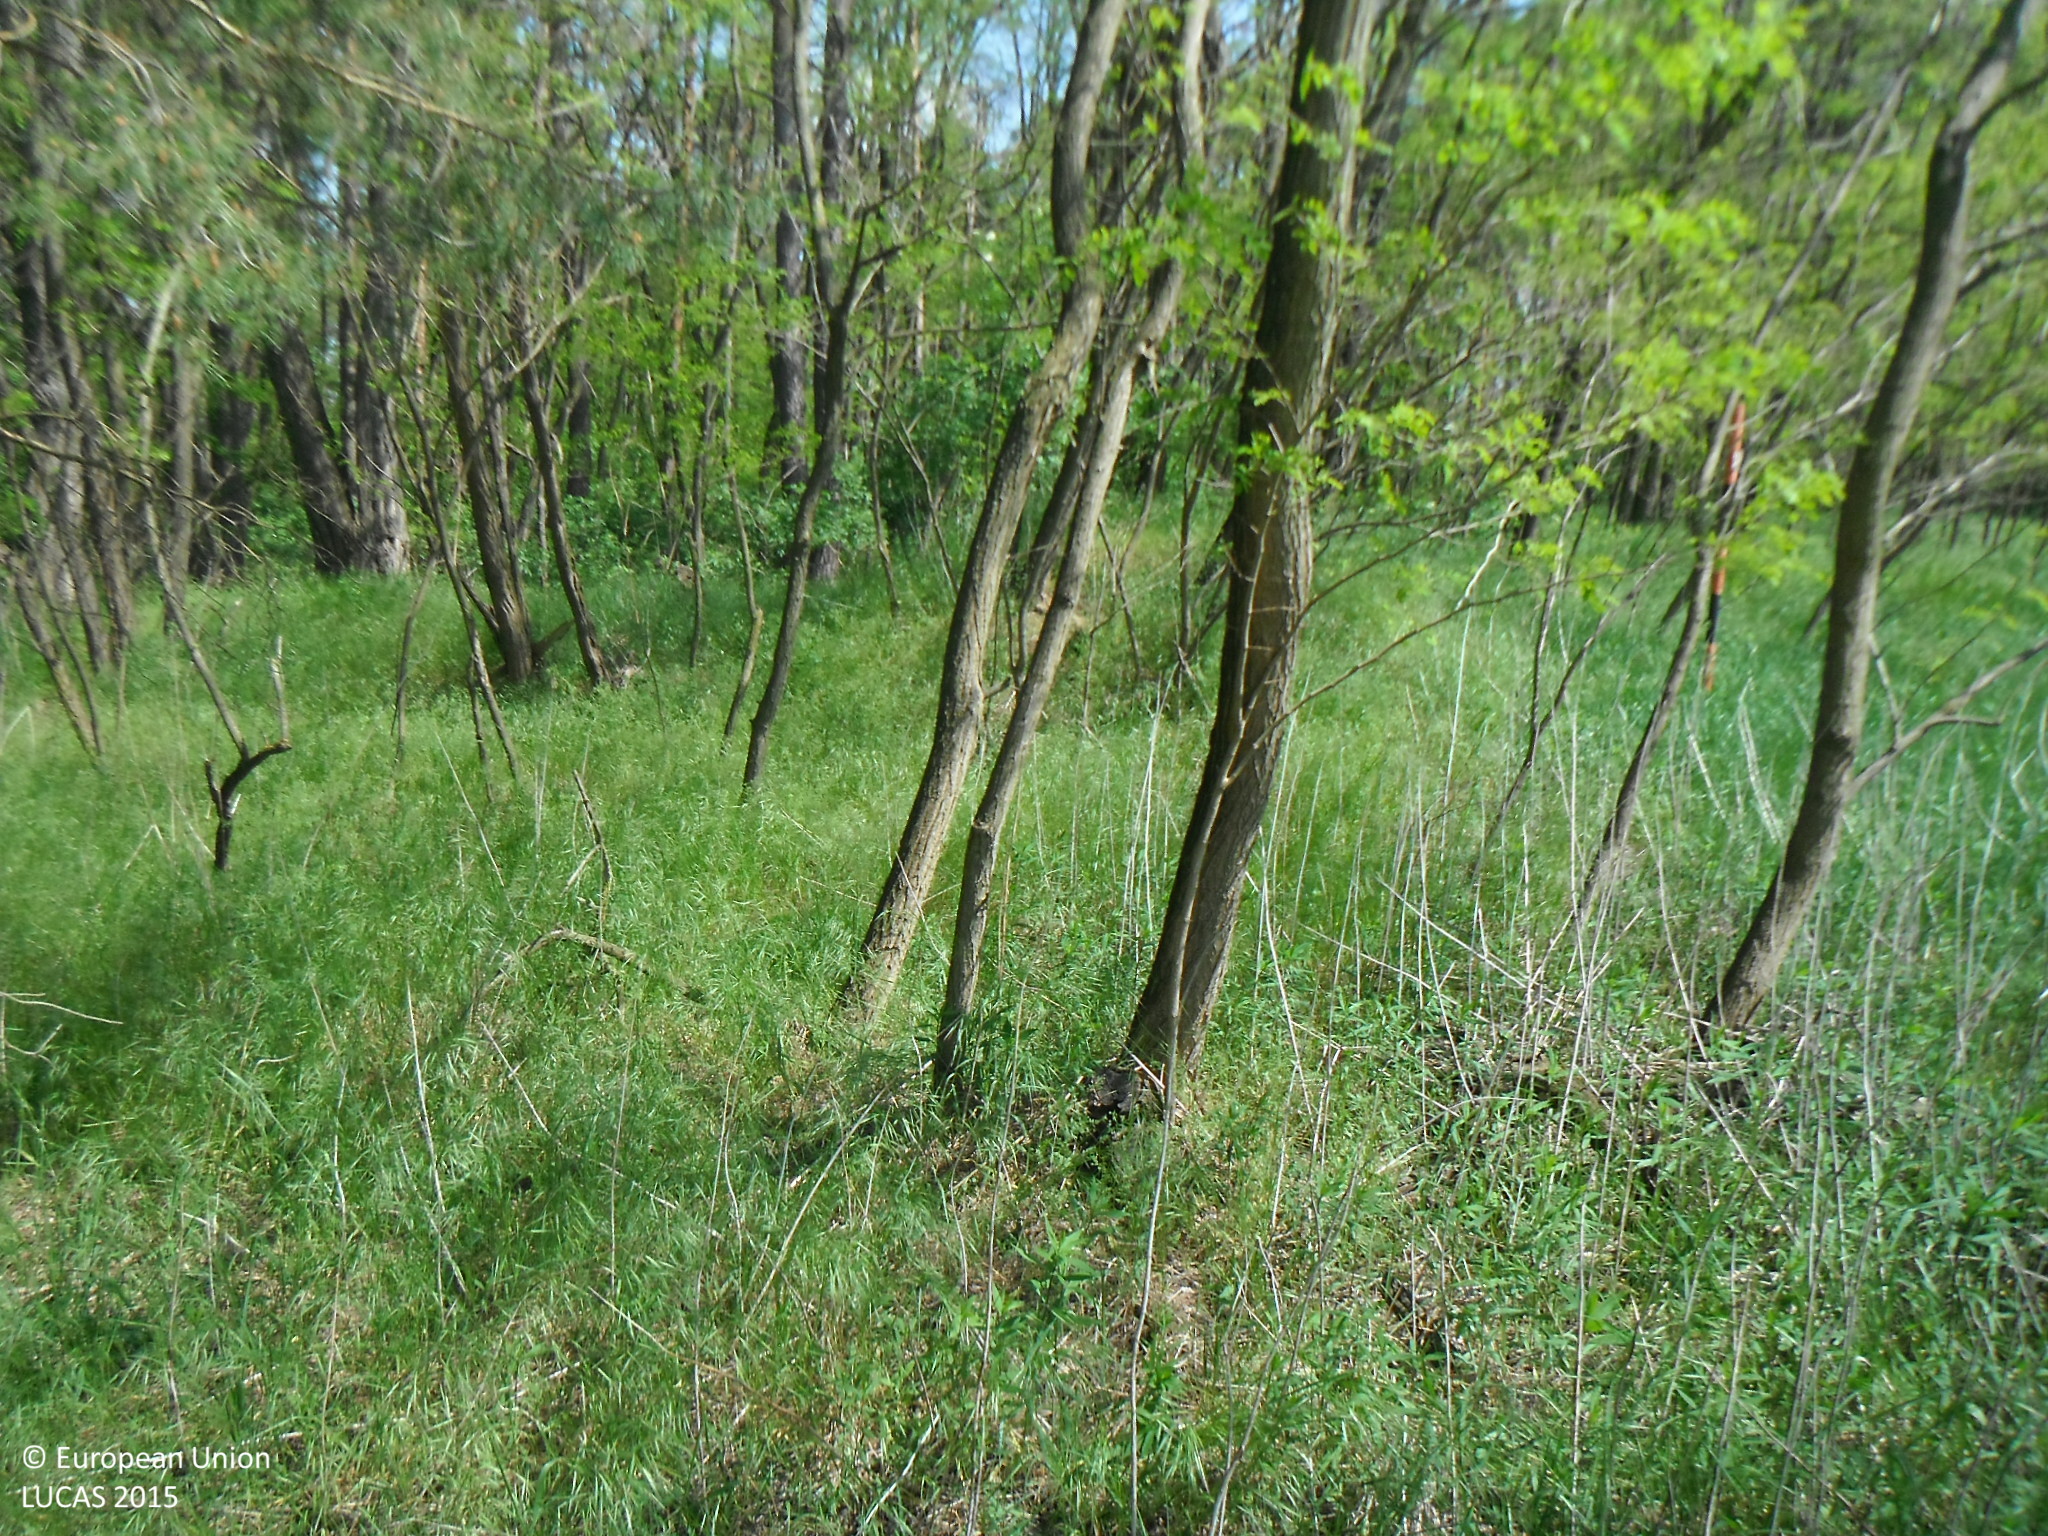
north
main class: Woodland
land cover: Broadleaved woodland
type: exotic forest
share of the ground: 50 - 75 %
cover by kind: broadleaved forest trees 60 %, herbaceous plants 35 %, shrubs 5 %
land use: Semi-natural and natural areas not in use
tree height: > 5 m
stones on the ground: < 10 %
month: May
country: SK
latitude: 48.5420
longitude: 17.0110
